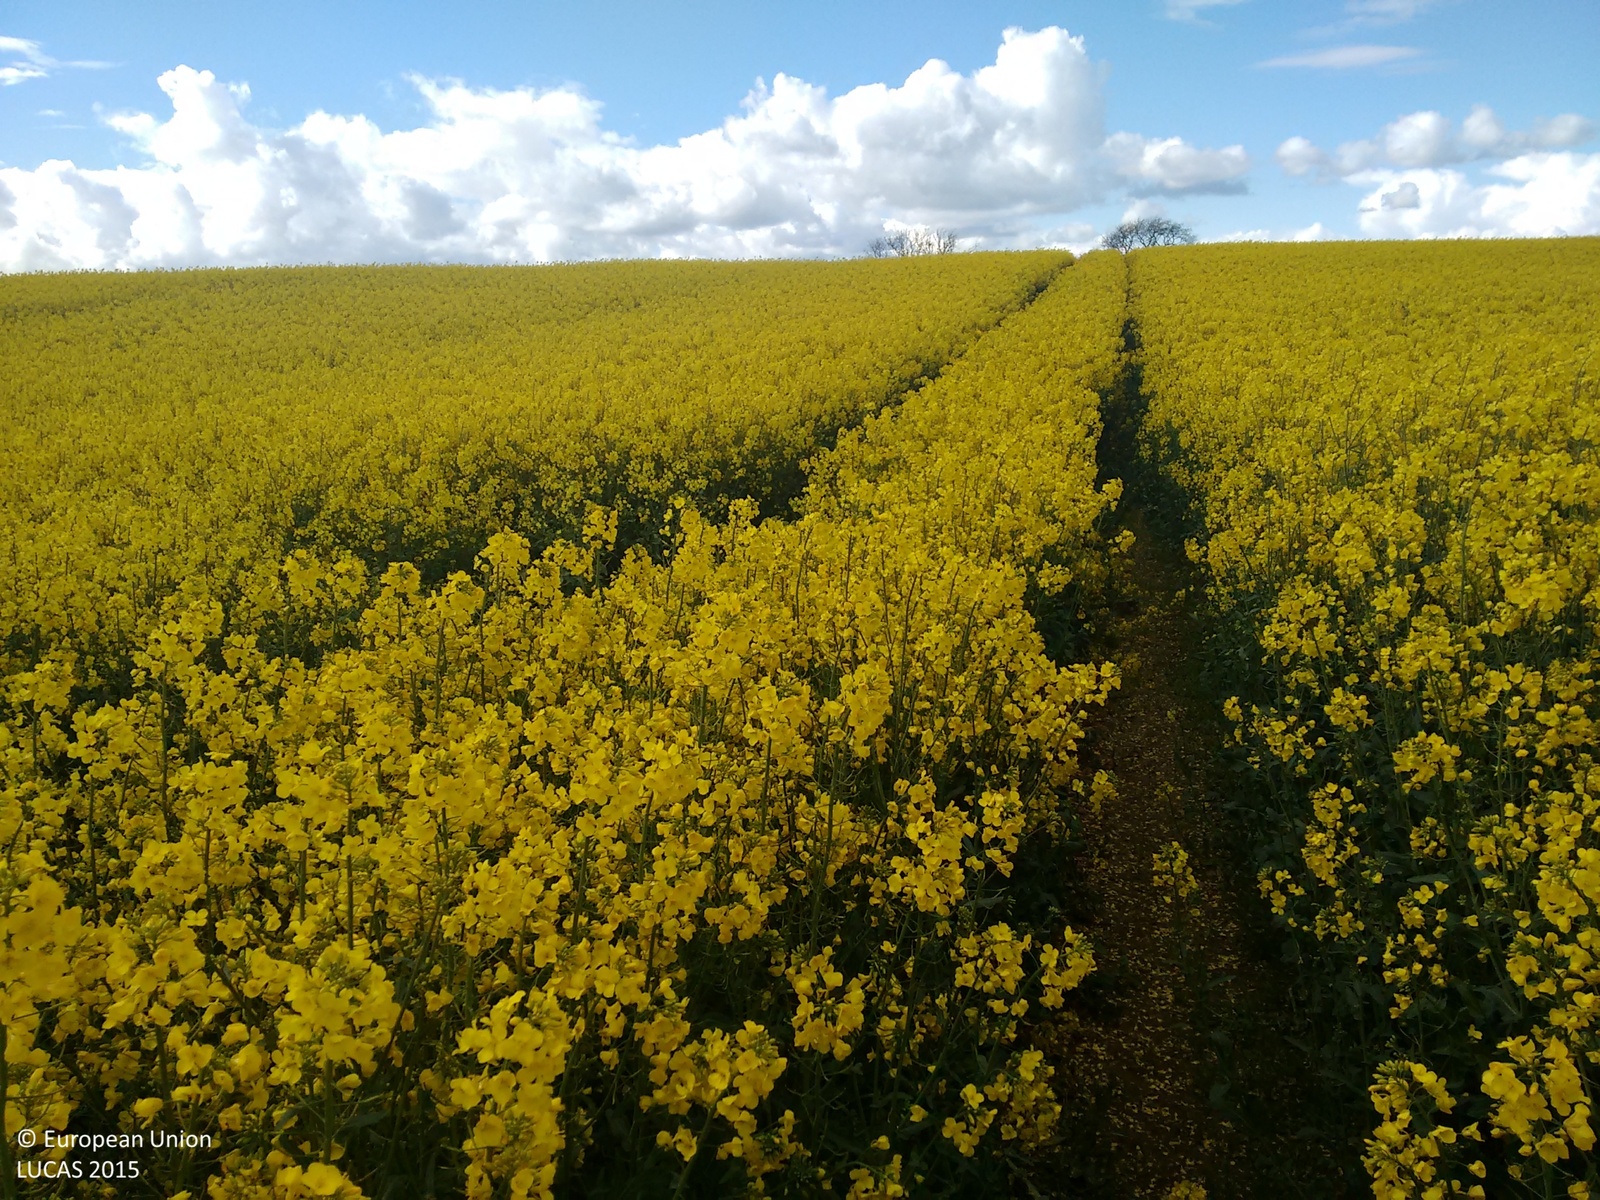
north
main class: Cropland
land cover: Rape and turnip rape
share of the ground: > 75 %
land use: Agriculture (excluding fallow land and kitchen gardens)
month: May
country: GB
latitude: 55.7530
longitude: -2.3420
